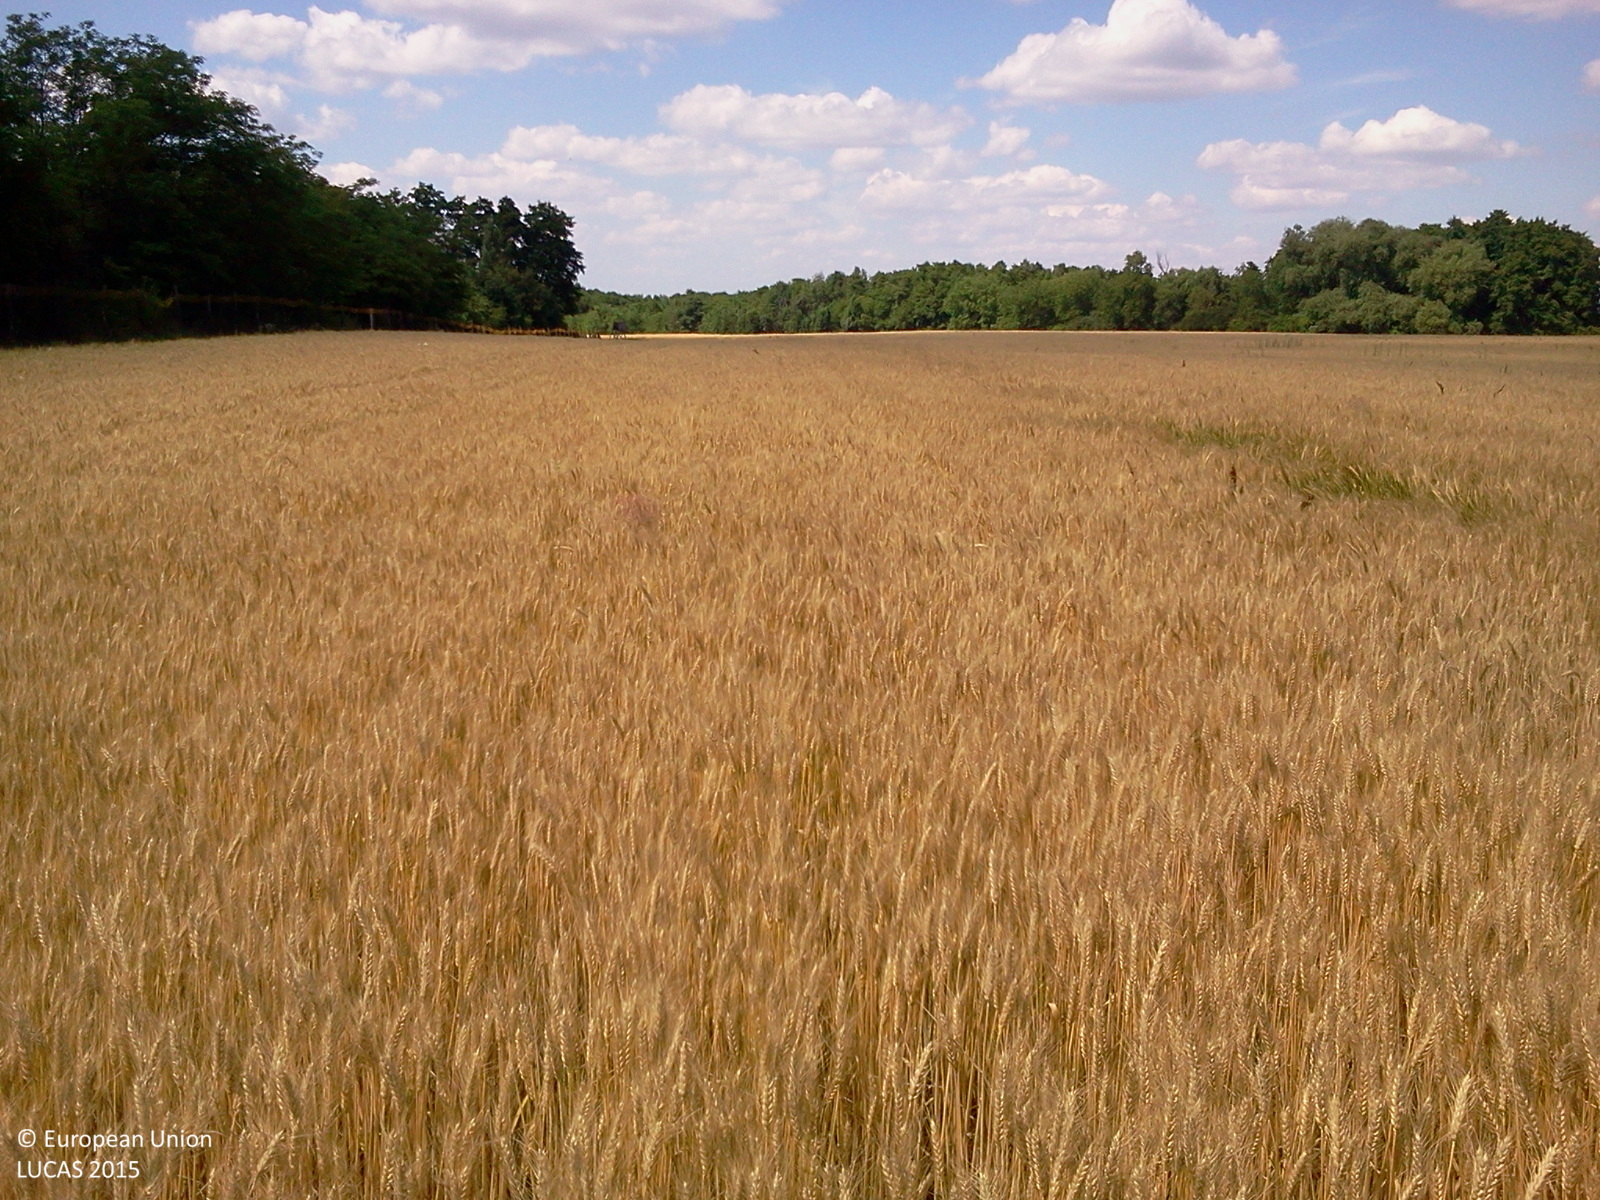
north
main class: Cropland
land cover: Durum wheat
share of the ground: > 75 %
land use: Agriculture (excluding fallow land and kitchen gardens)
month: June
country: HU
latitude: 46.9244
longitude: 17.1621
